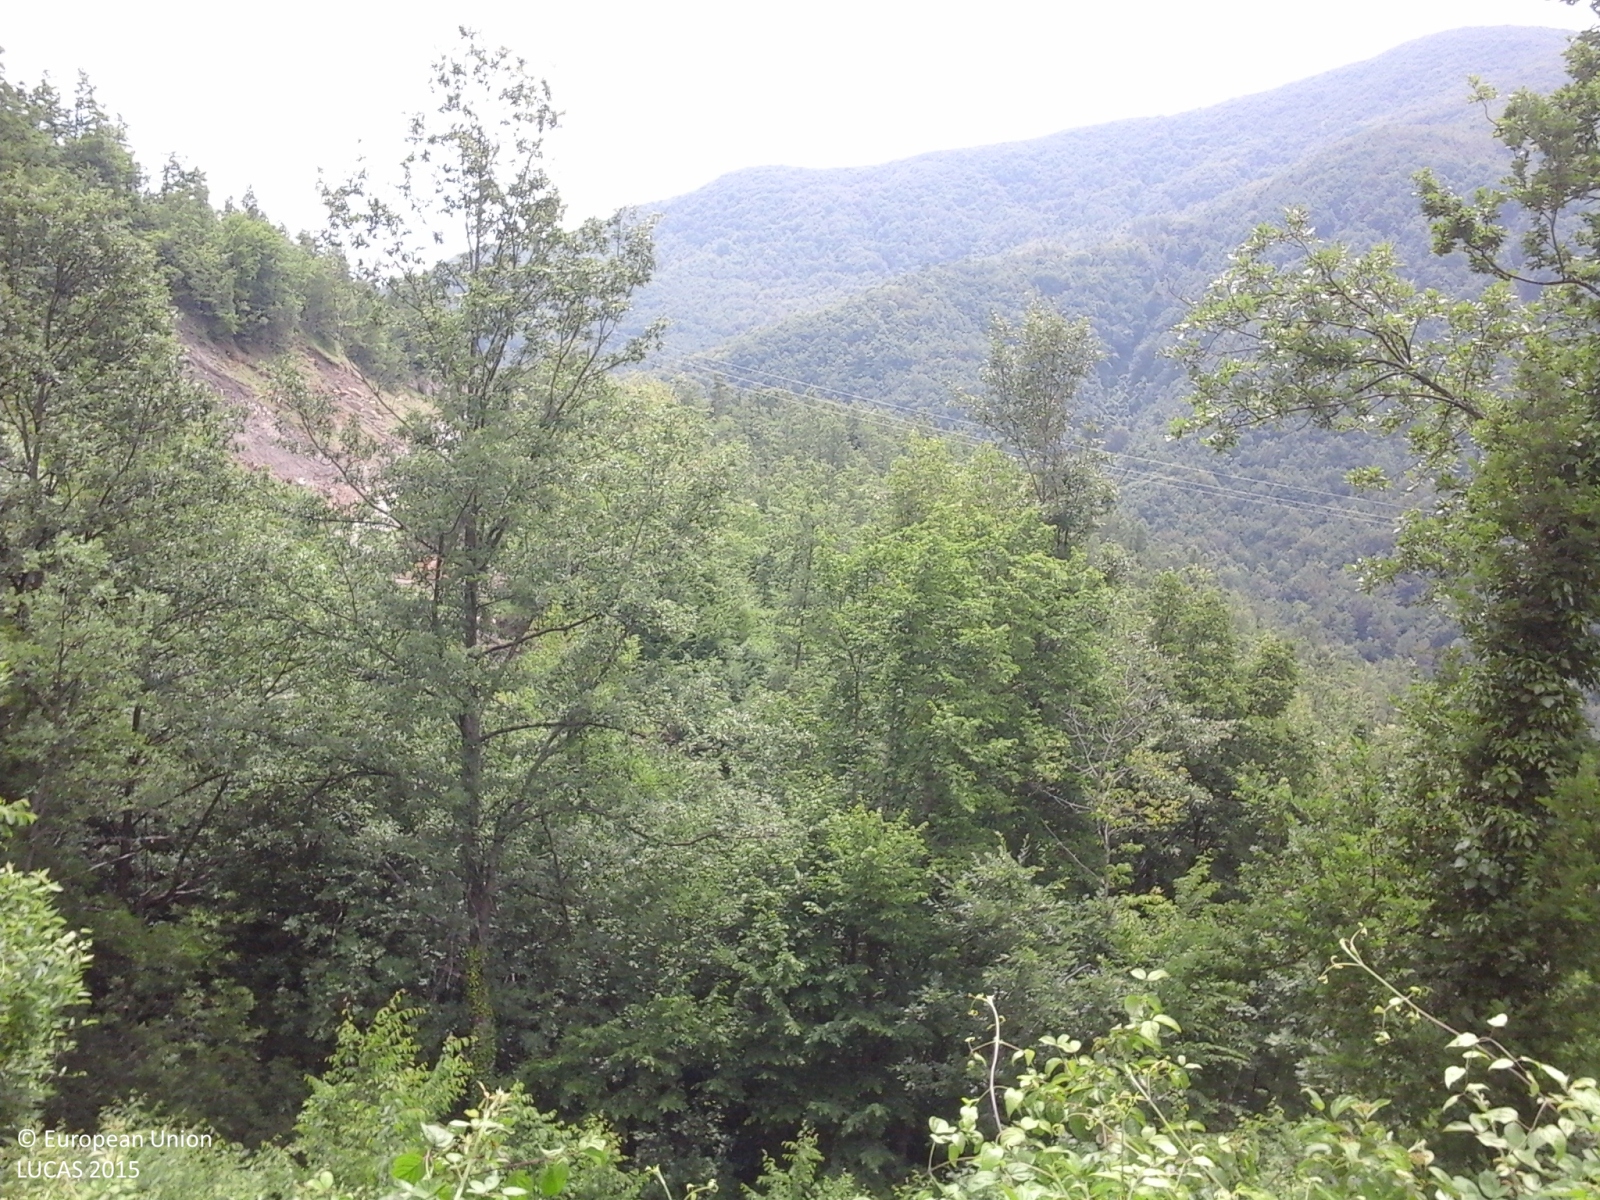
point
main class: Woodland
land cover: Broadleaved woodland
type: thermophilous deciduous forest
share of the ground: > 75 %
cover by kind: broadleaved forest trees 80 %, shrubs 20 %
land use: Forestry
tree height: > 5 m
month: June
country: IT
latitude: 44.6023
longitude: 9.6103
